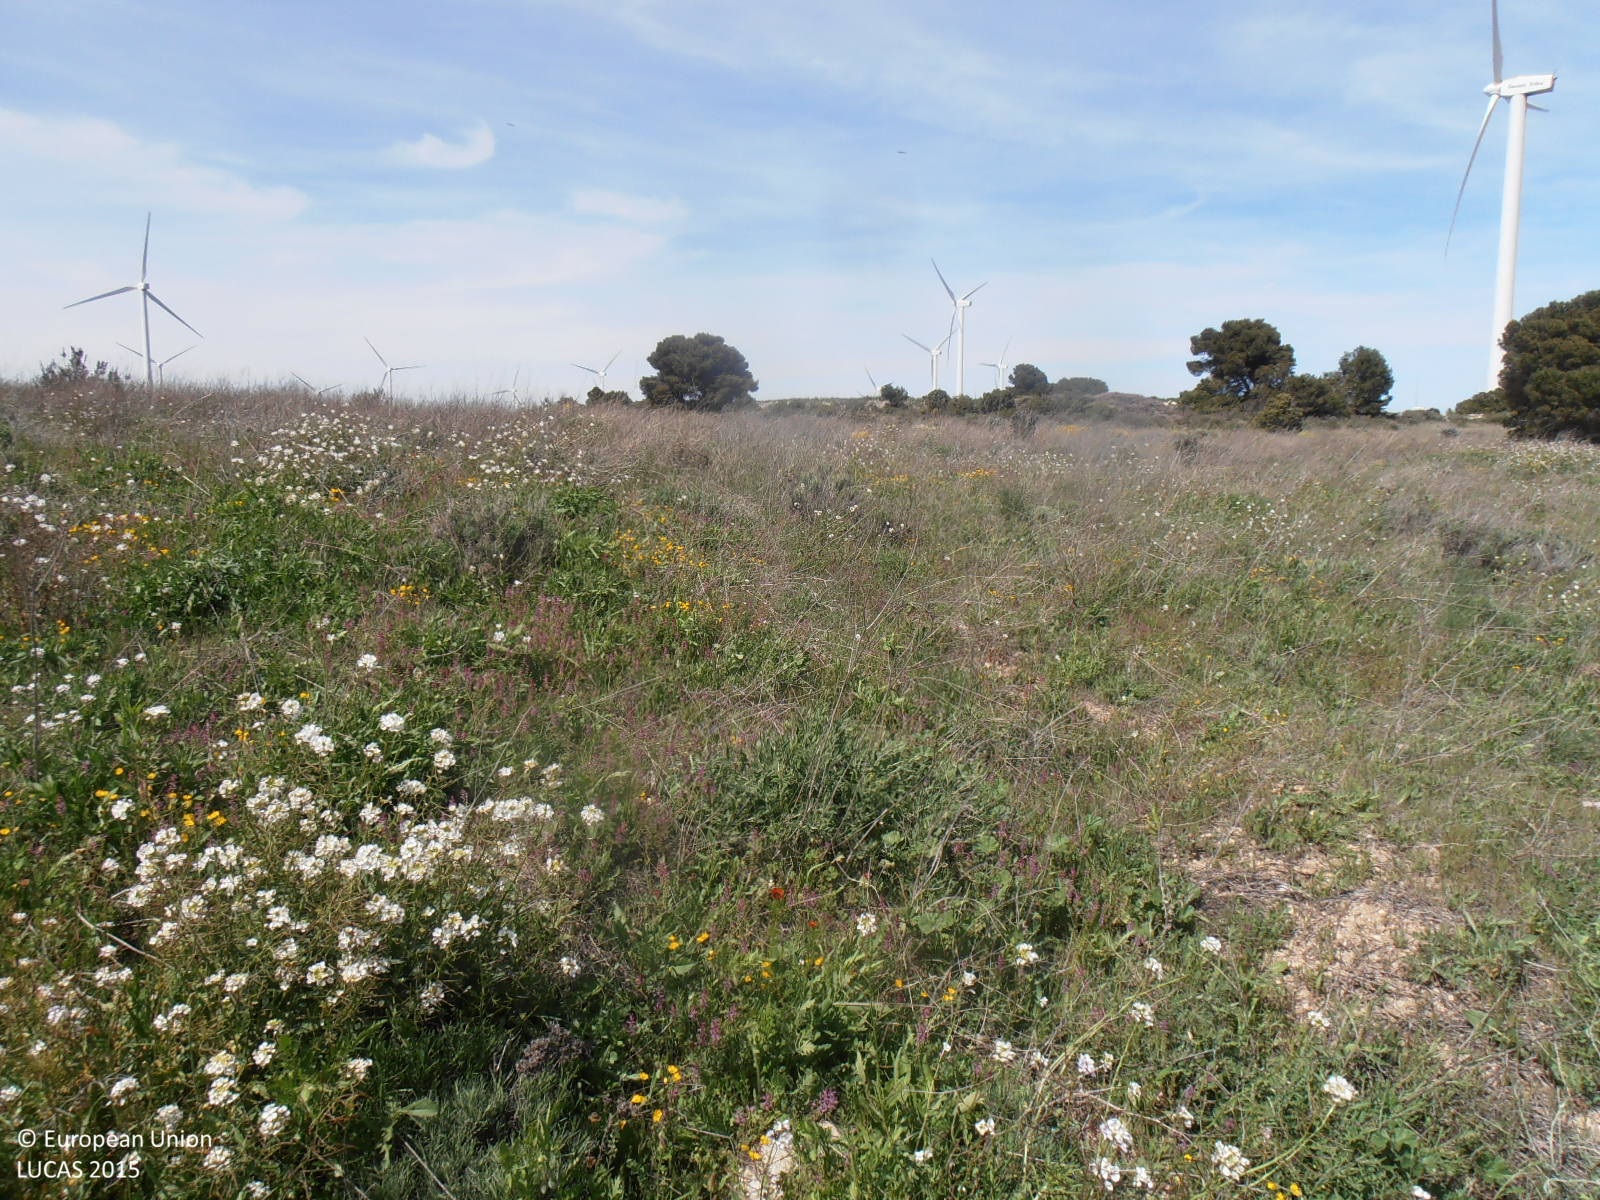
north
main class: Grassland
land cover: Grassland without tree/shrub cover
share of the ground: > 75 %
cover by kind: herbaceous plants 95 %, shrubs 5 %
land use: Abandoned areas
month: April
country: ES
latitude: 41.3655
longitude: -0.9583
